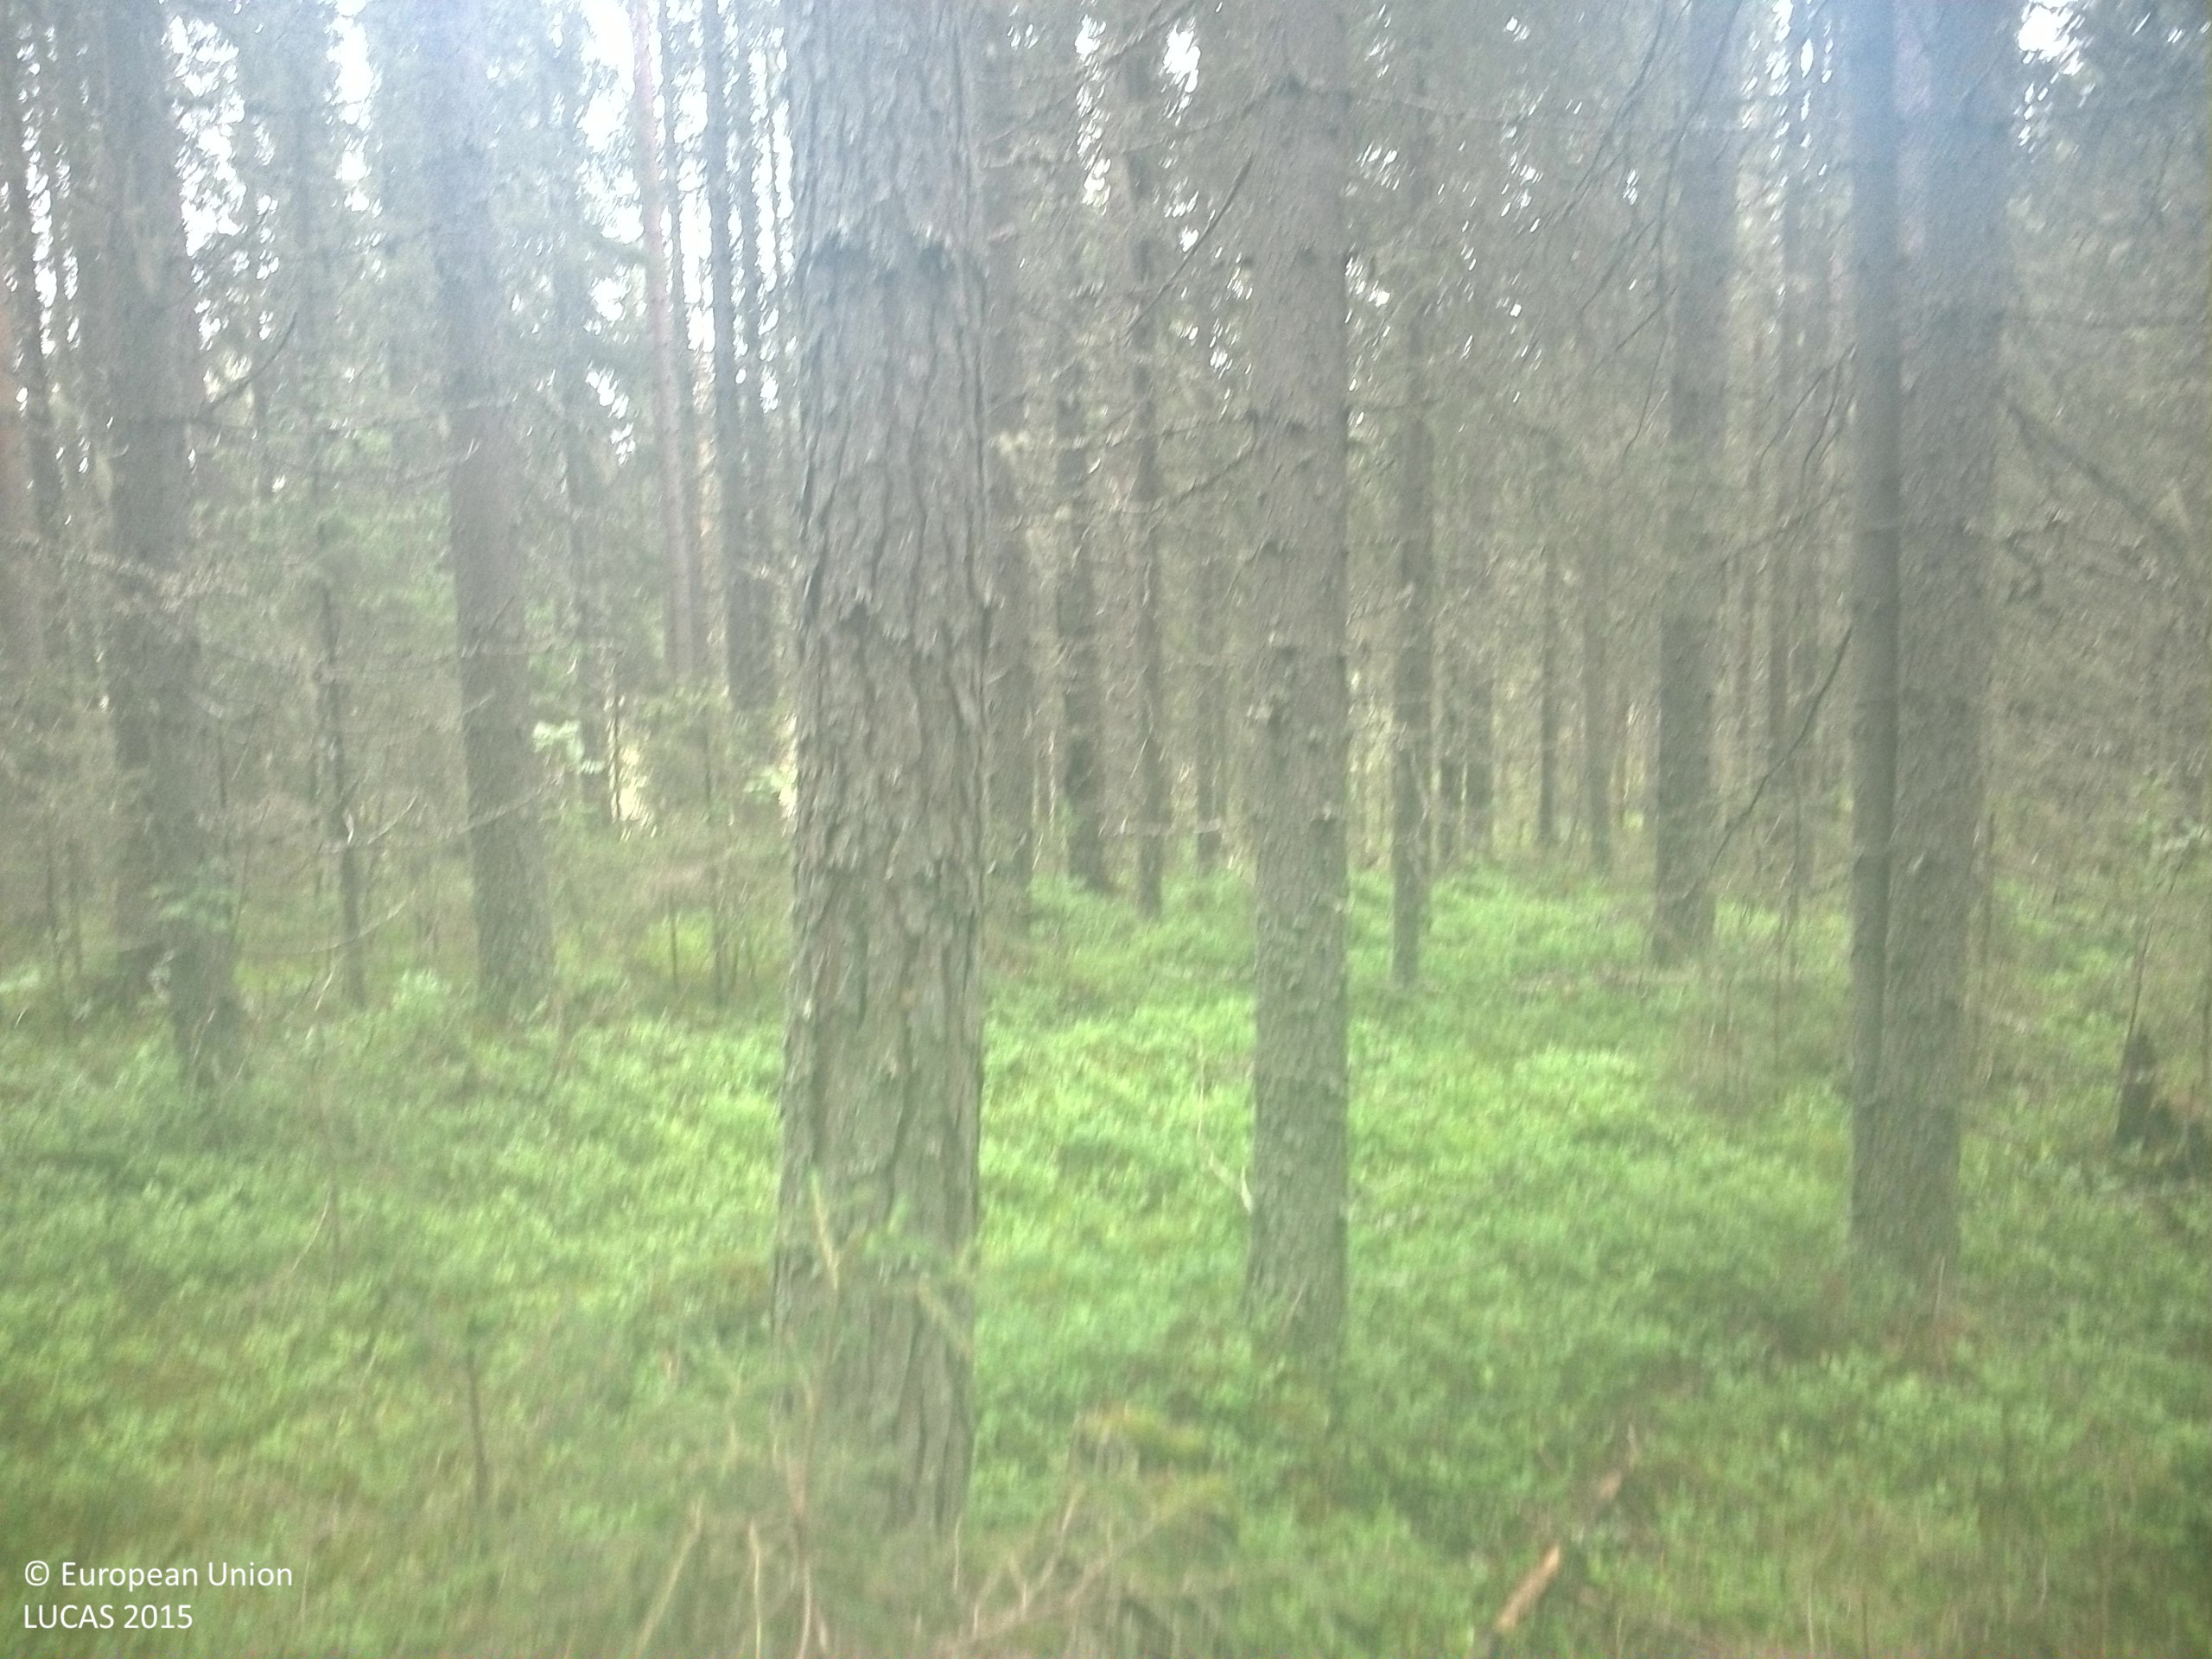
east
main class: Woodland
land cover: Spruce dominated coniferous woodland
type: boreal forest
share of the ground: > 75 %
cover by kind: coniferous forest trees 80 %, shrubs 15 %, broadleaved forest trees 5 %
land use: Forestry
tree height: > 5 m
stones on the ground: < 10 %
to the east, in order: Spruce dominated coniferous woodland; Grassland with sparse tree/shrub cover; Rivers and streams; Grassland with sparse tree/shrub cover; Ditches and canals; Paved roads, cycling and walking lanes; Ditches and canals; Pine dominated mixed woodland
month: July
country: SE
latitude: 63.6222
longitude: 18.5492
